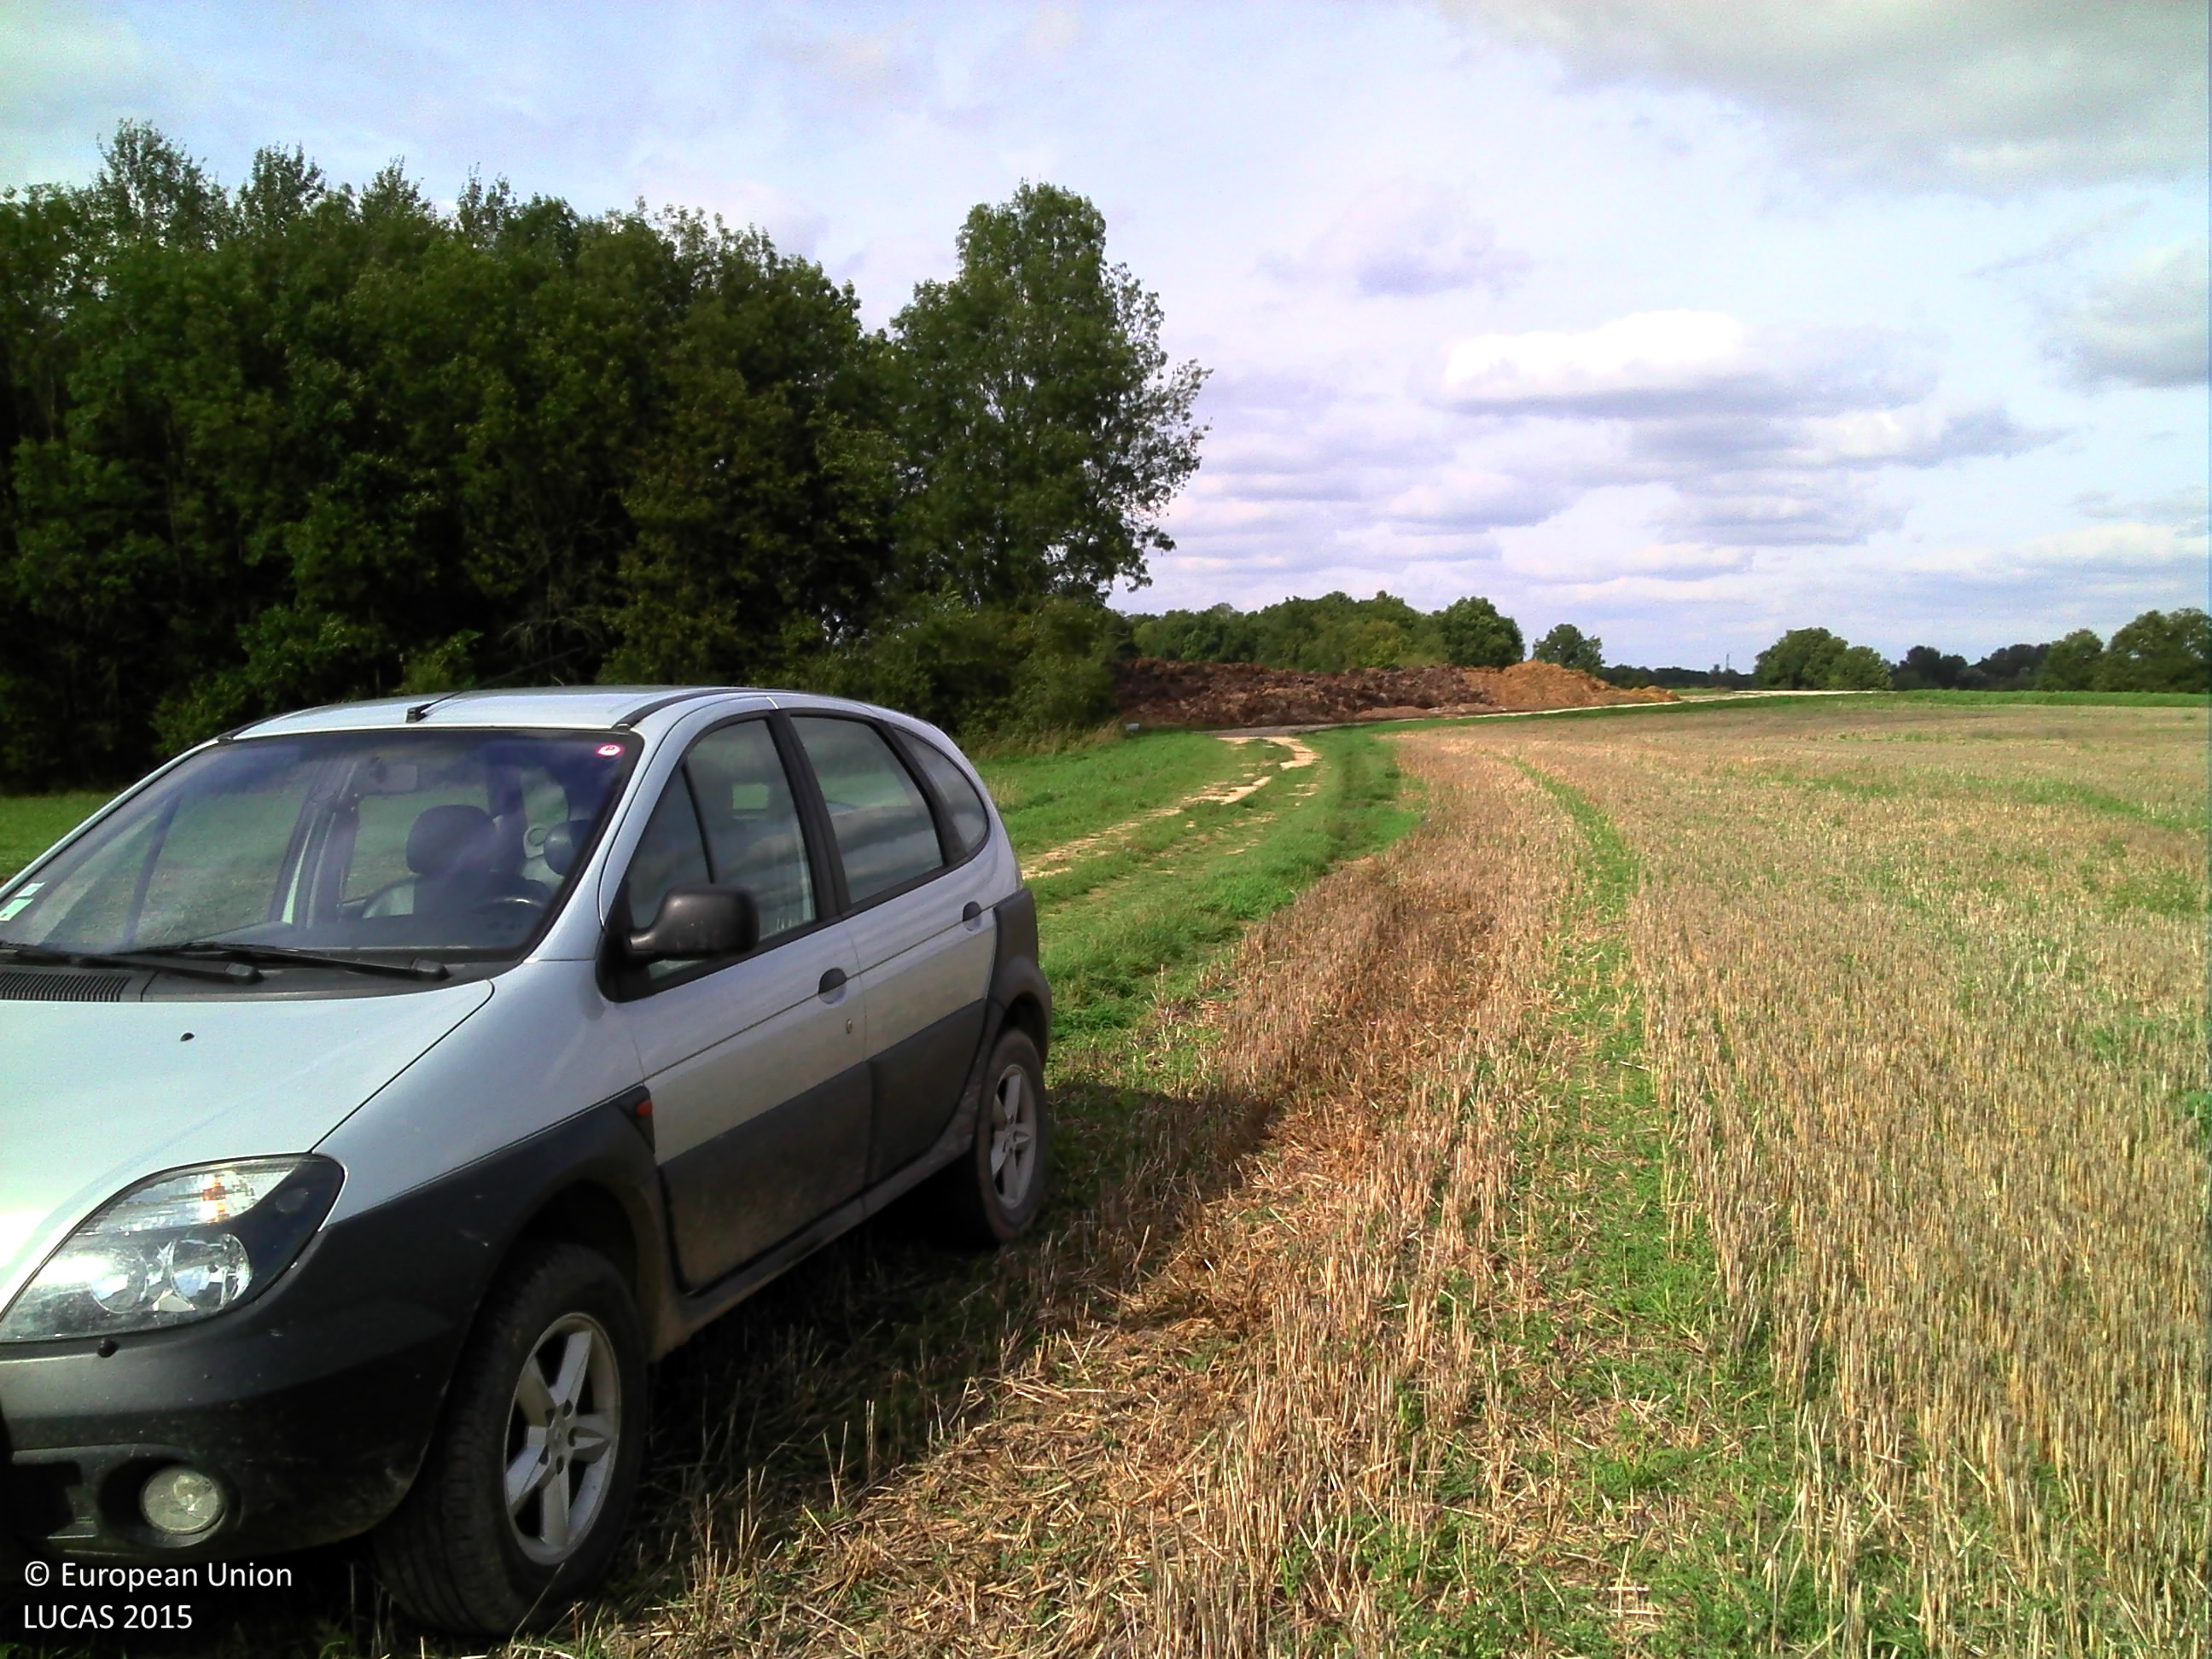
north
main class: Cropland
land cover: Common wheat
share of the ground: 10 - 25 %
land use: Agriculture (excluding fallow land and kitchen gardens)
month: September
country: FR
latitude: 48.4879
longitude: 4.5988
